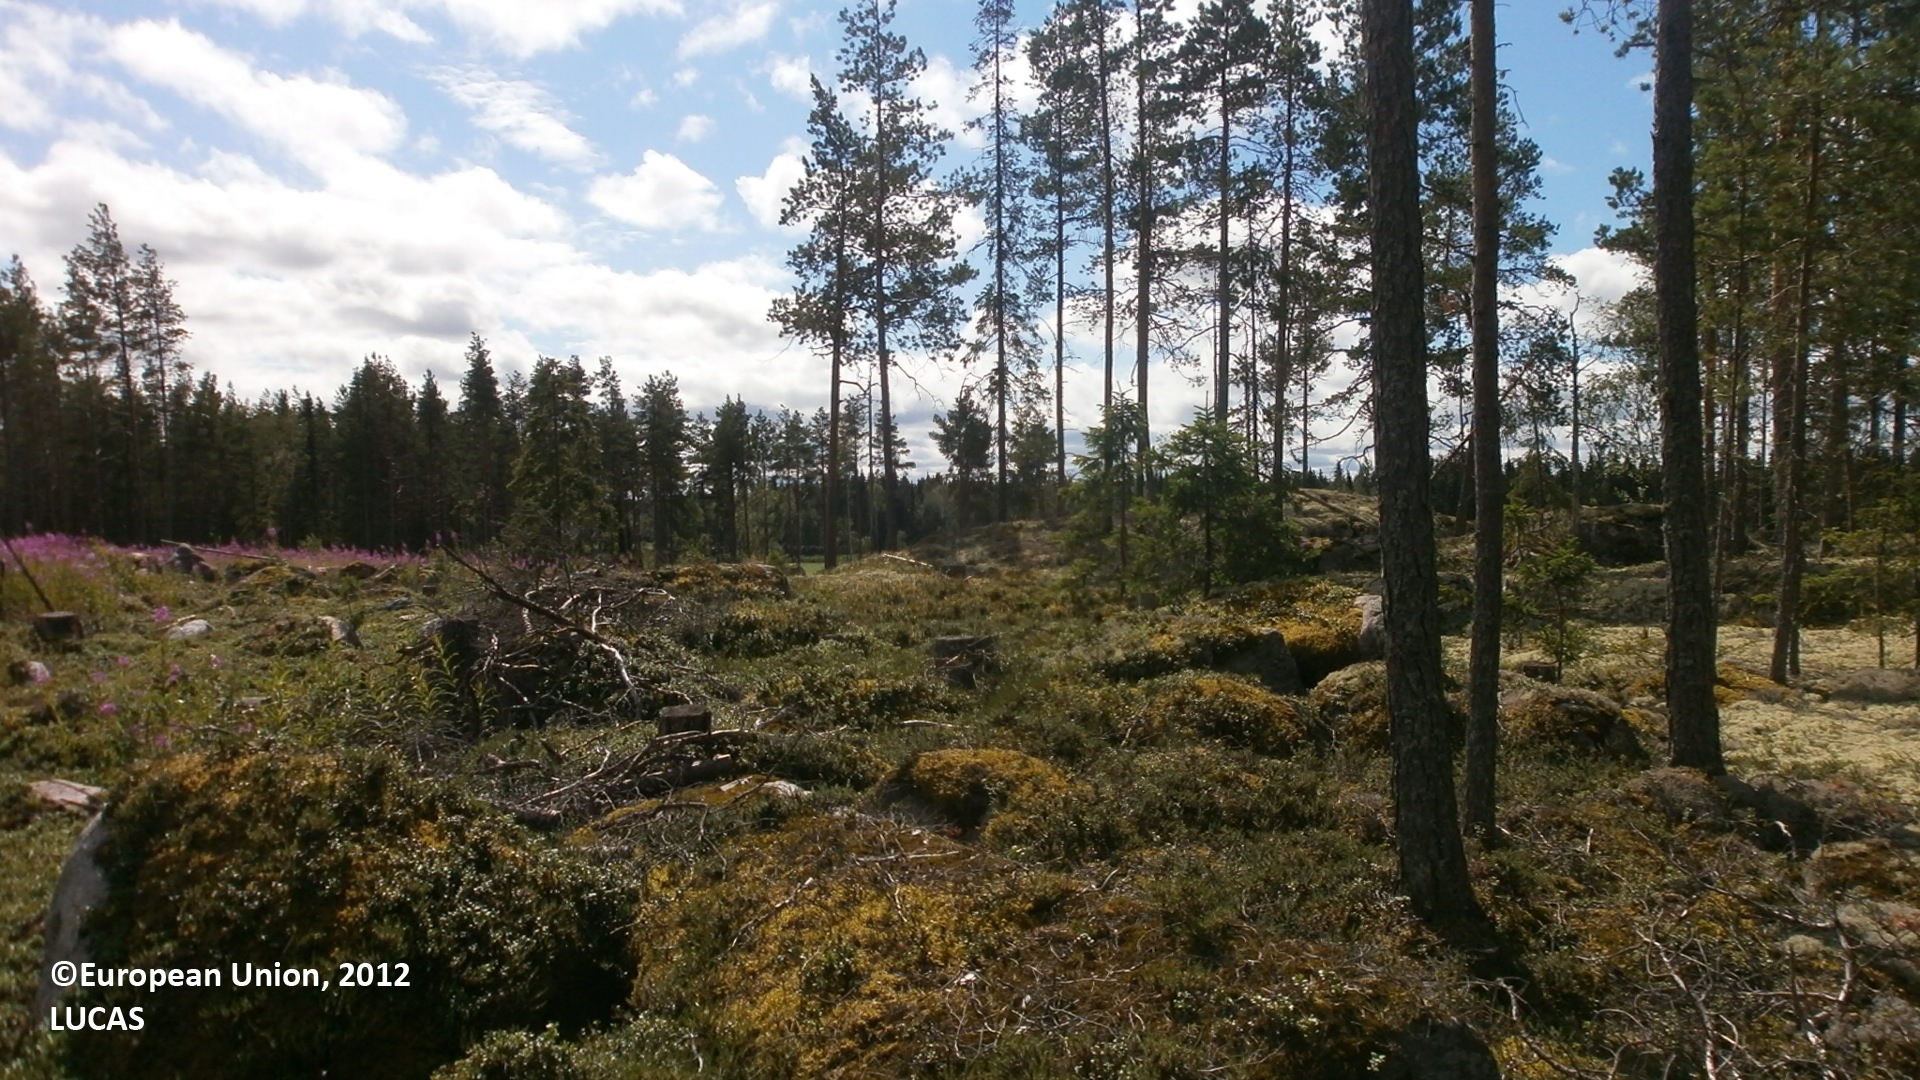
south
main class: Shrubland
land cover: Shrubland without tree cover
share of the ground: > 75 %
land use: Forestry
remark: Clear cut
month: July
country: FI
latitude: 64.0204
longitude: 23.7075
